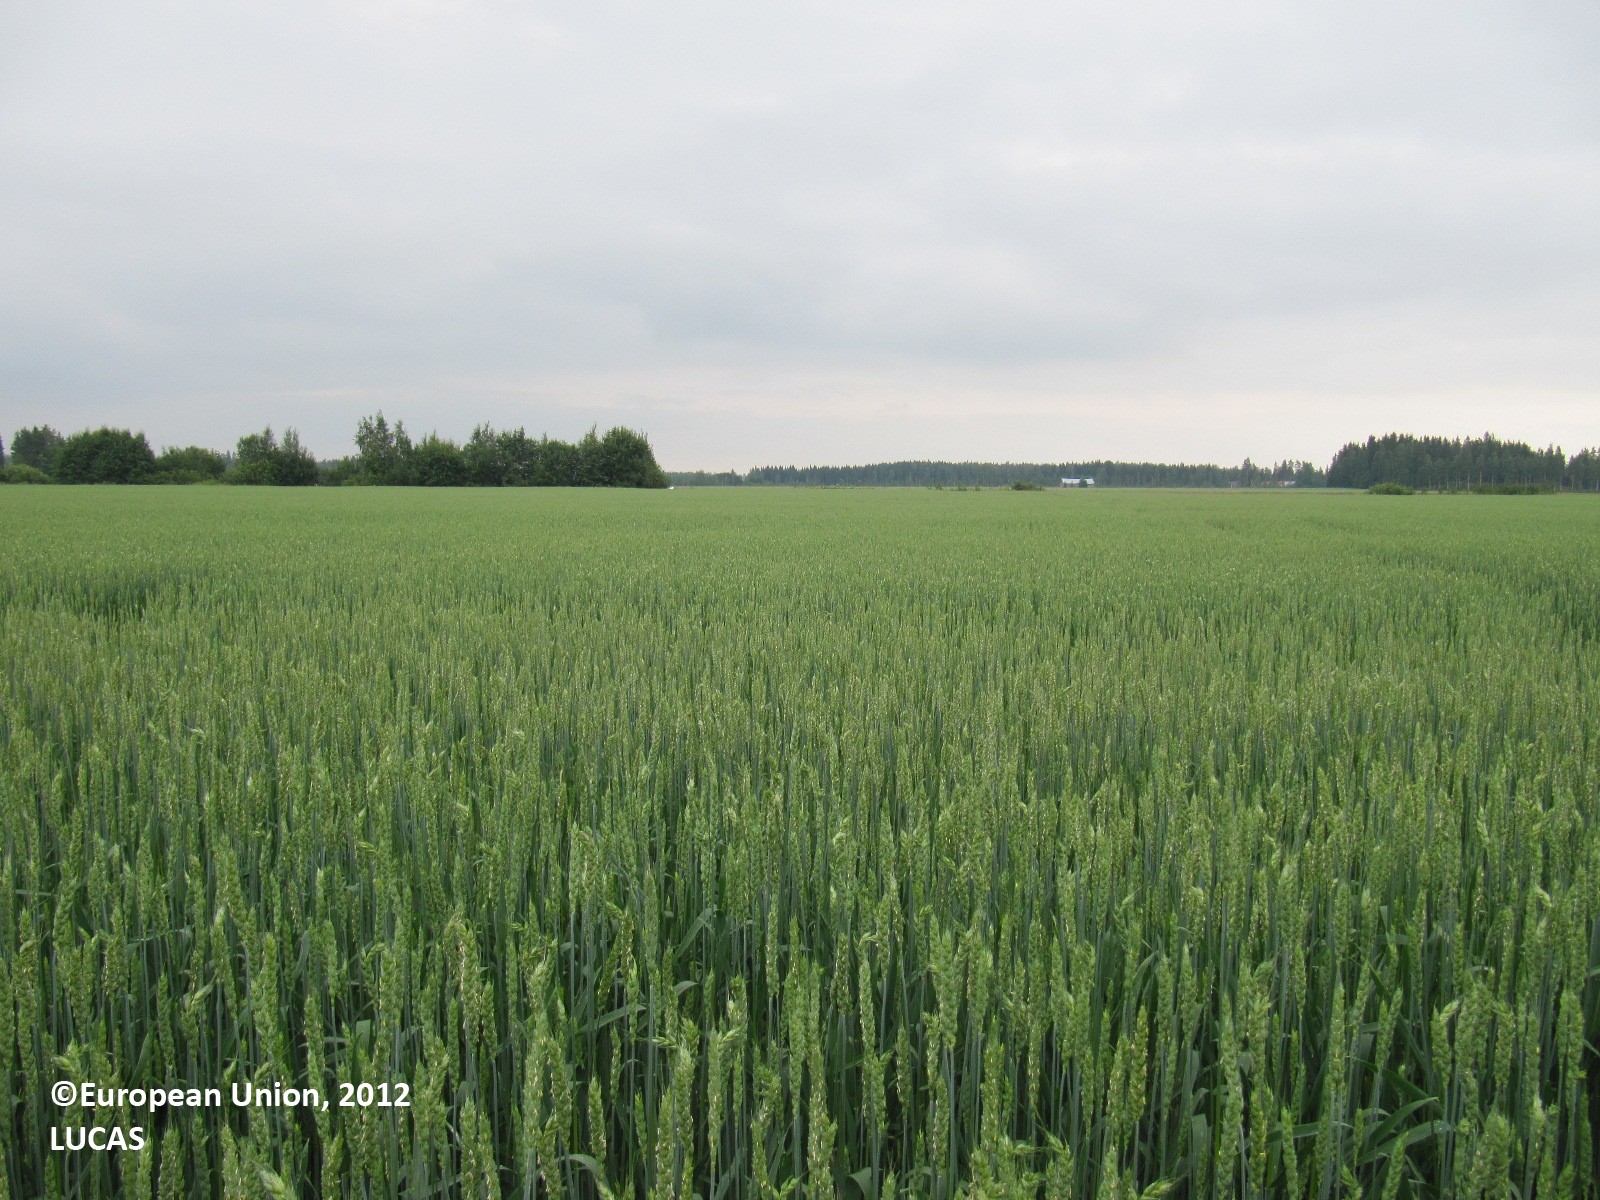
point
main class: Cropland
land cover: Common wheat
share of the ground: > 75 %
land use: Agriculture (excluding fallow land and kitchen gardens)
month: July
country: FI
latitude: 60.6976
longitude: 23.3255
